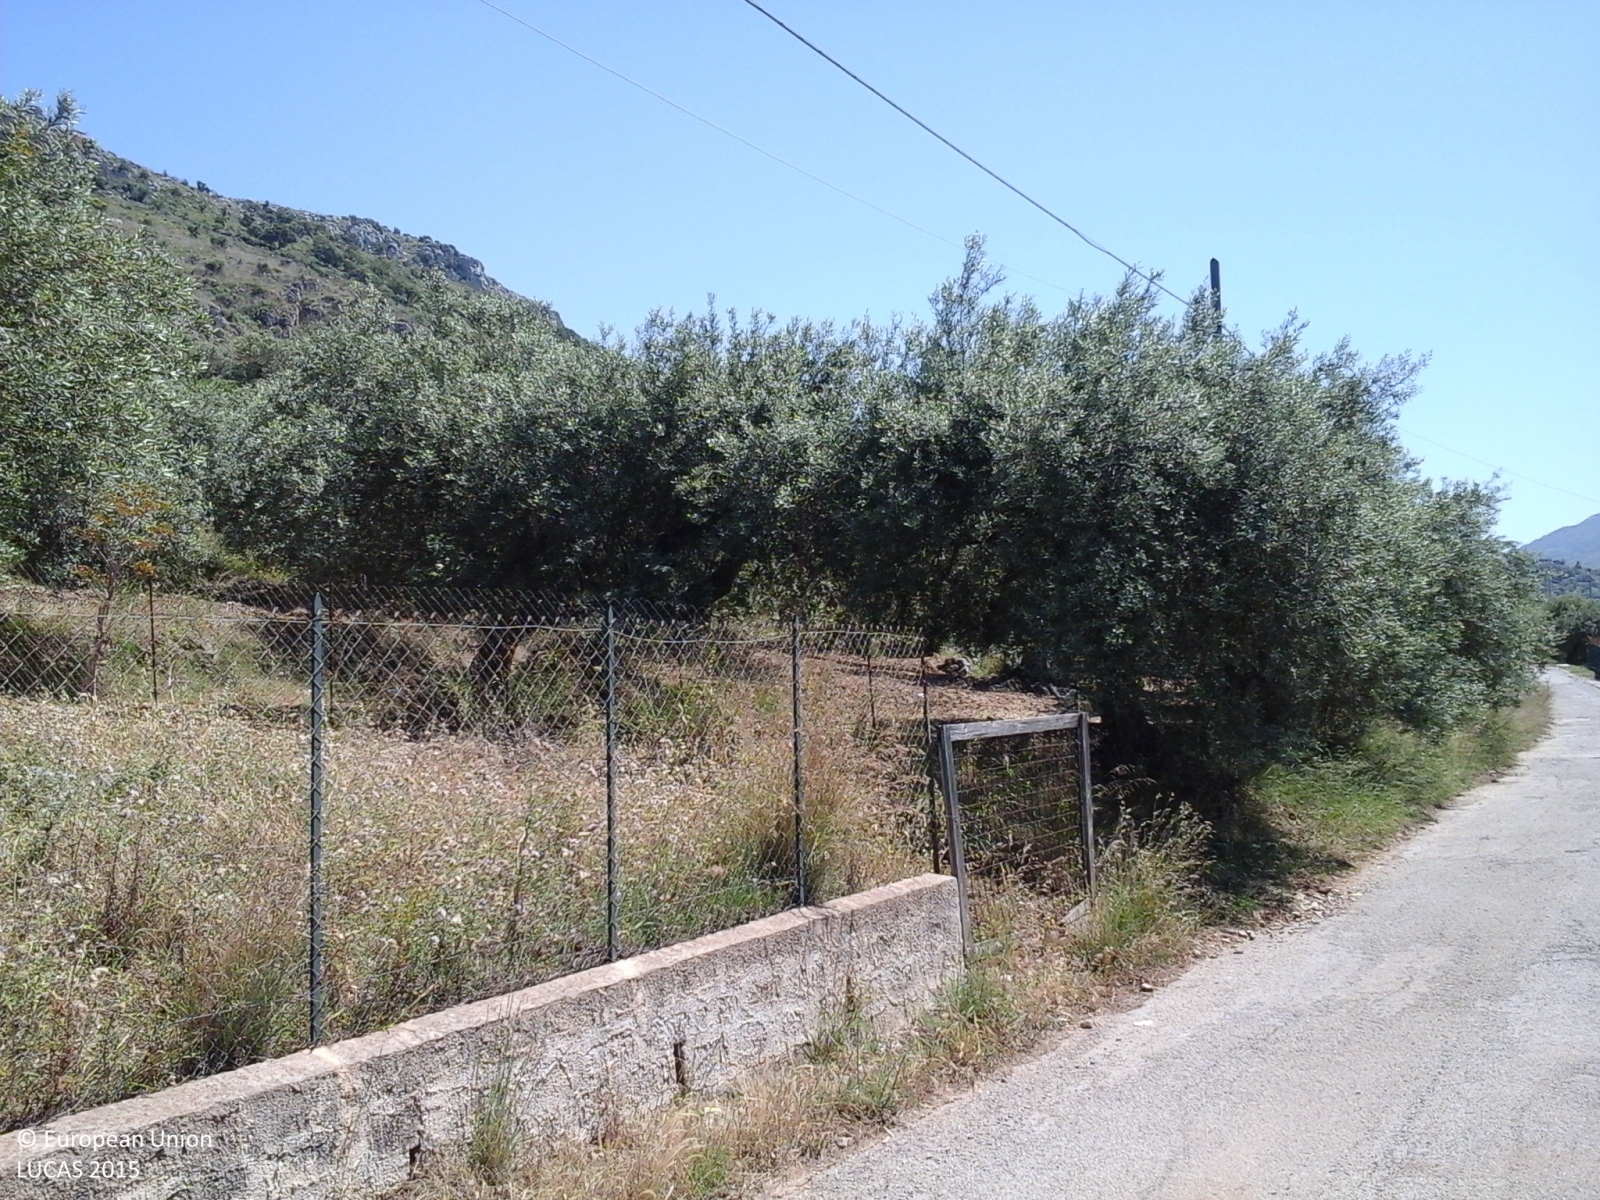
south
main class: Cropland
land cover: Olive groves
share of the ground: 50 - 75 %
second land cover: Spontaneously vegetated surfaces
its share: > 75 %
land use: Agriculture (excluding fallow land and kitchen gardens)
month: June
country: IT
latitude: 37.9871
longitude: 13.6293
